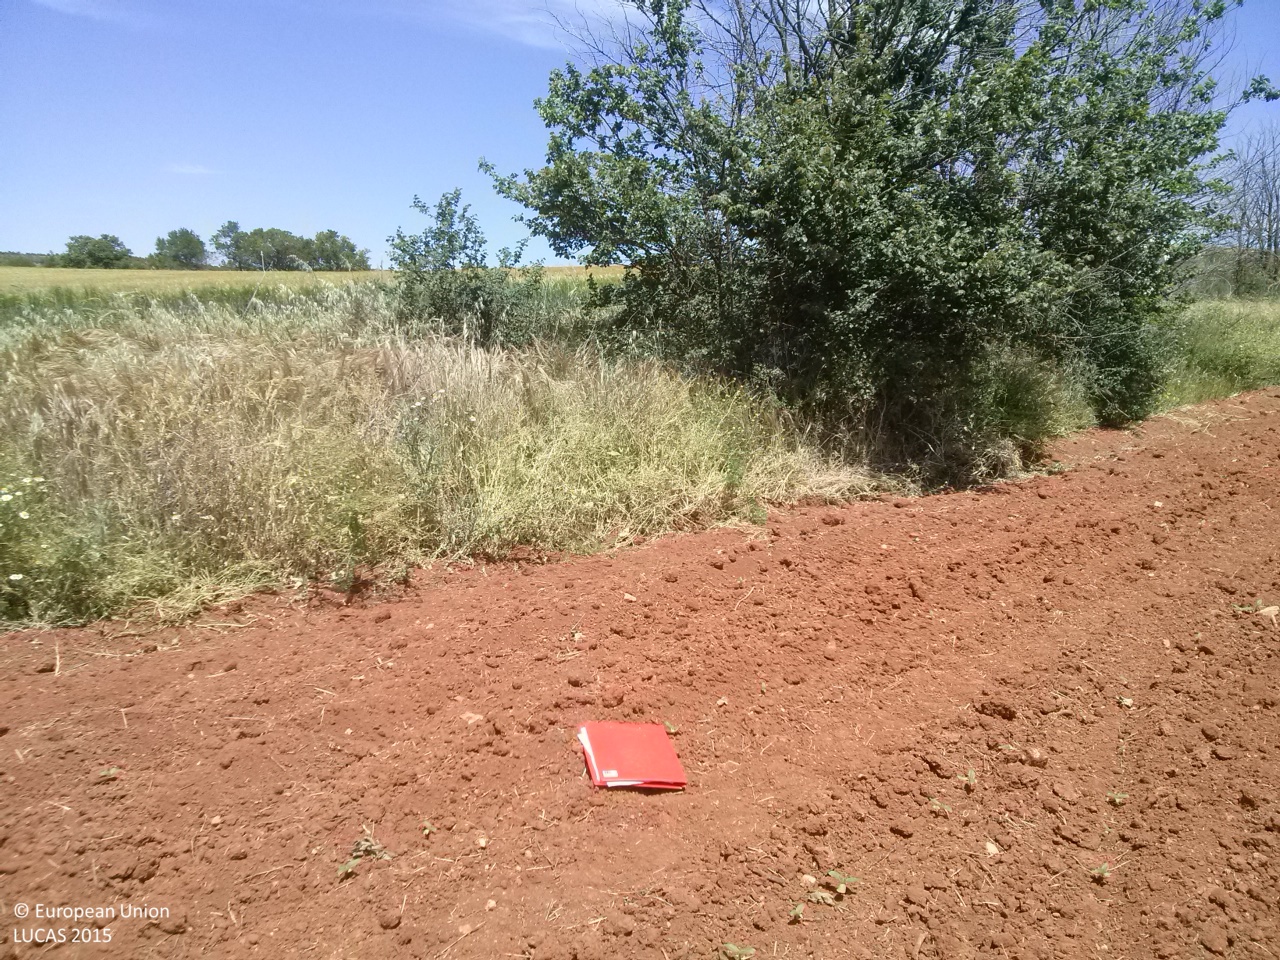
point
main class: Cropland
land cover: Sunflower
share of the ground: < 10 %
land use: Agriculture (excluding fallow land and kitchen gardens)
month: May
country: ES
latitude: 40.0428
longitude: -2.8329
